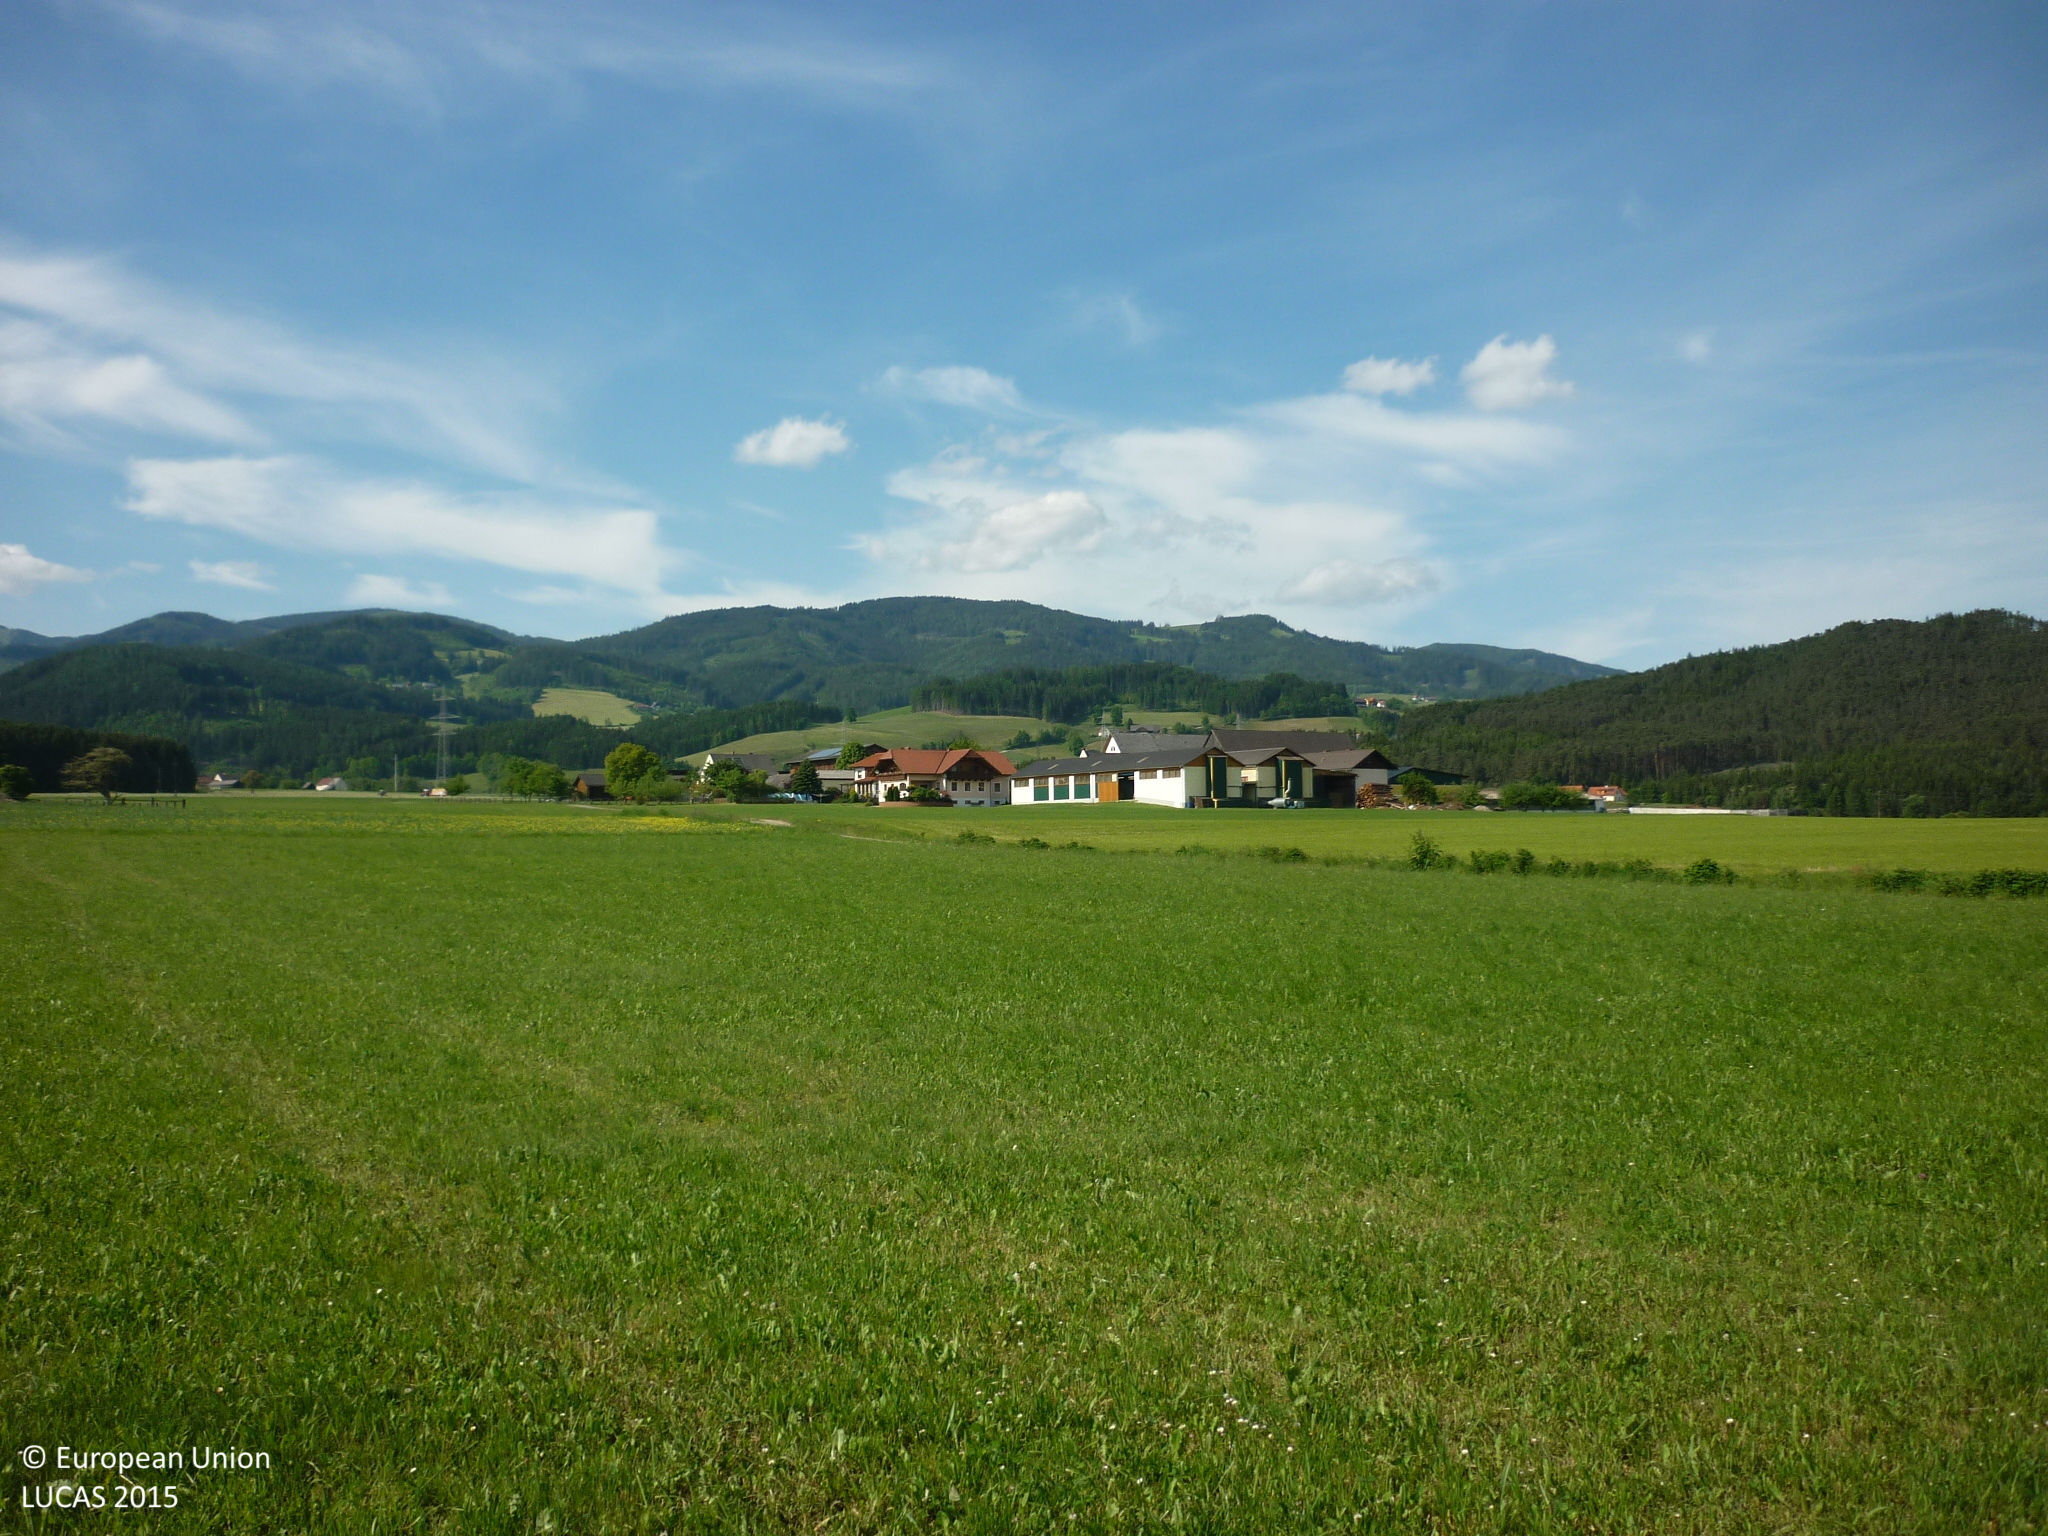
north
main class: Grassland
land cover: Grassland without tree/shrub cover
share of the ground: > 75 %
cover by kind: herbaceous plants 100 %
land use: Agriculture (excluding fallow land and kitchen gardens)
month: May
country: AT
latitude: 47.2682
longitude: 14.8765
